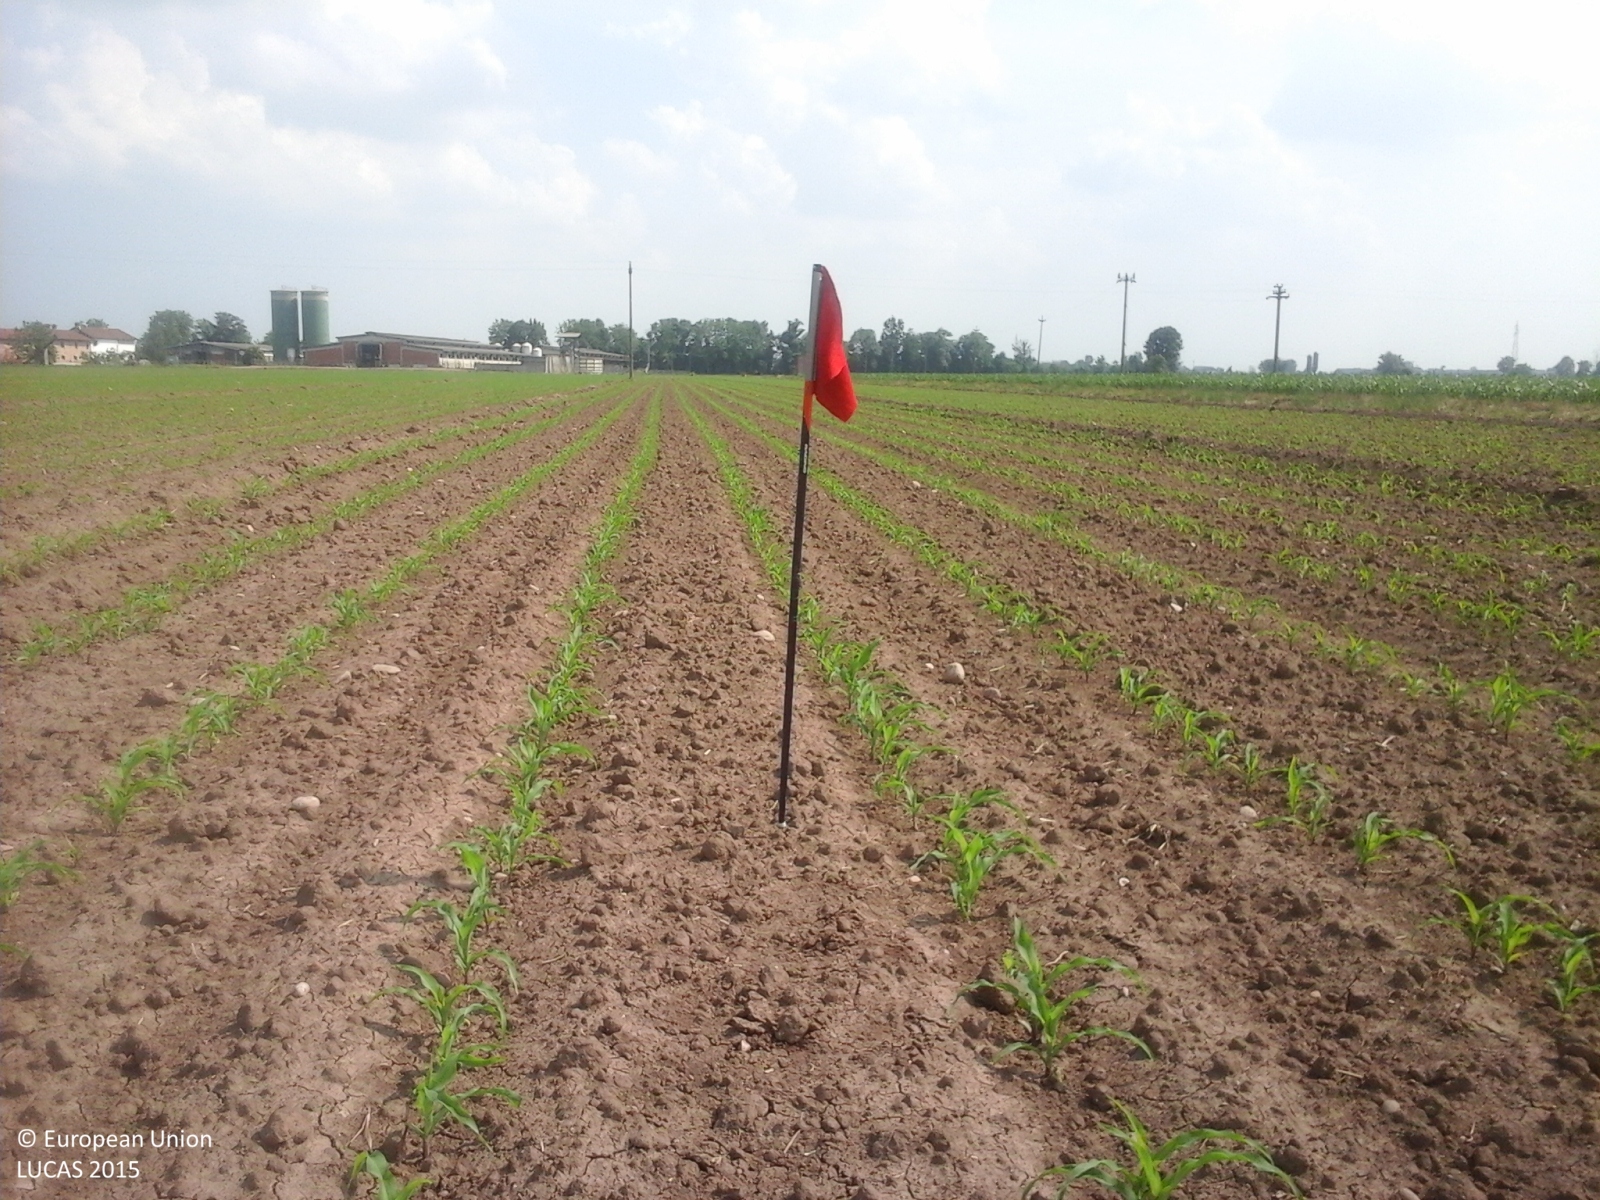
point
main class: Cropland
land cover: Maize
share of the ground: < 10 %
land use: Agriculture (excluding fallow land and kitchen gardens)
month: June
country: IT
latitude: 44.7410
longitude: 7.7438
